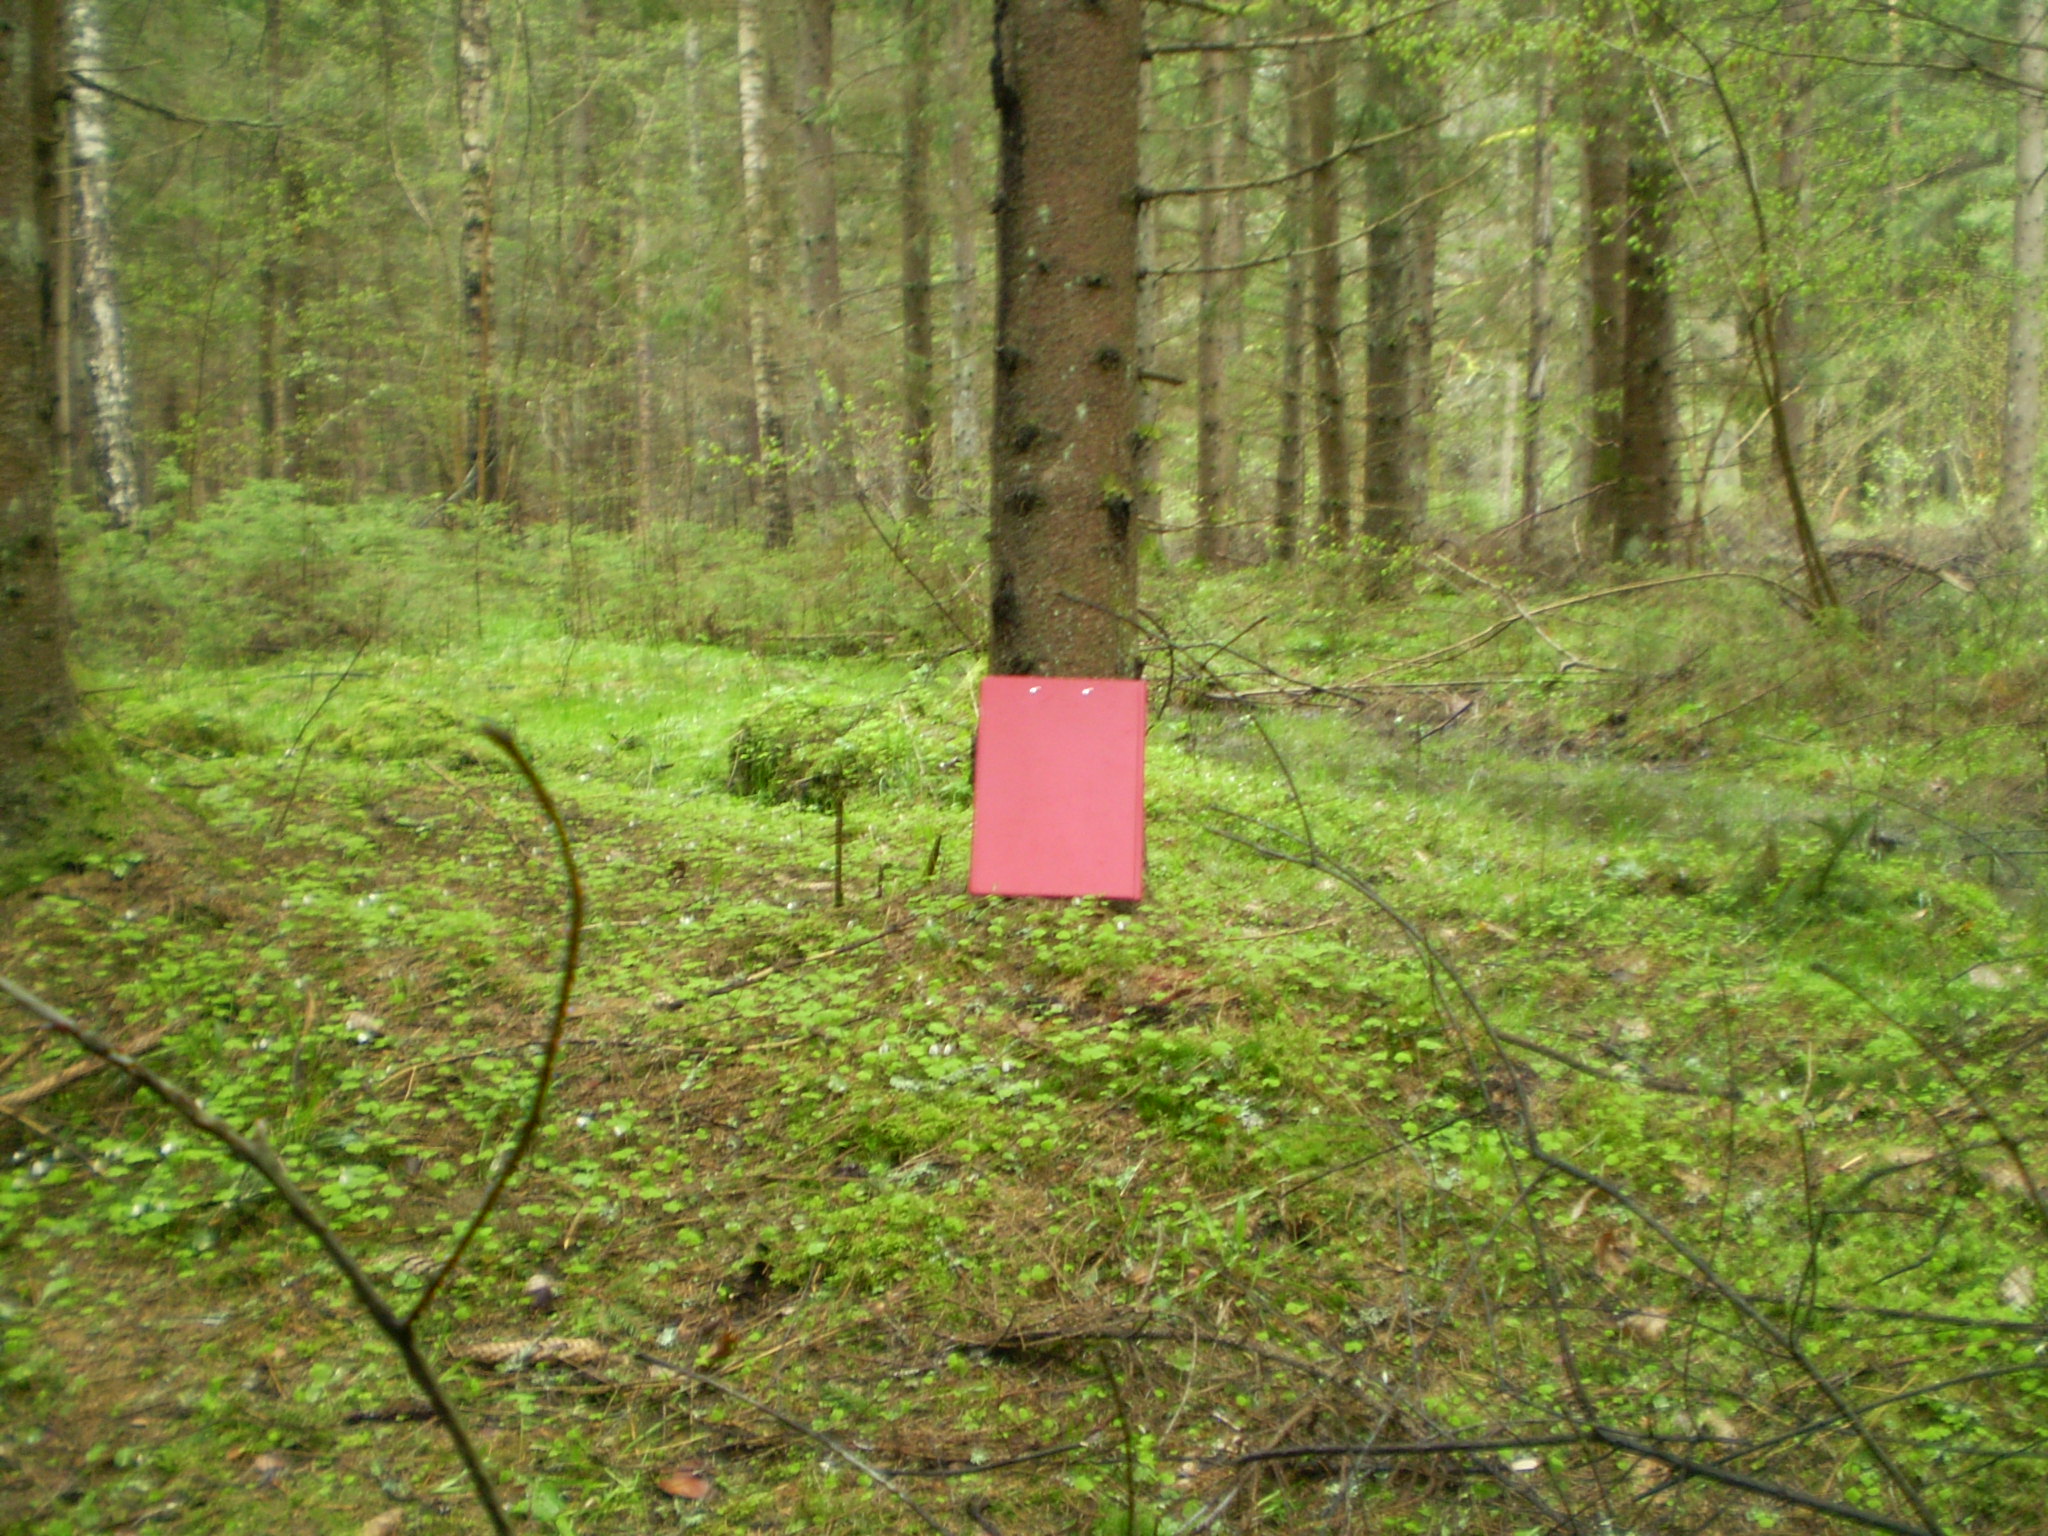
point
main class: Woodland
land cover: Spruce dominated coniferous woodland
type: hemiboreal forest and nemoral coniferous forest and mixed broadleaved-coniferous forest
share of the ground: > 75 %
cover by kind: coniferous forest trees 100 %
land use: Forestry
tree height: > 5 m
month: May
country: LT
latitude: 56.3021
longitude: 22.1245
